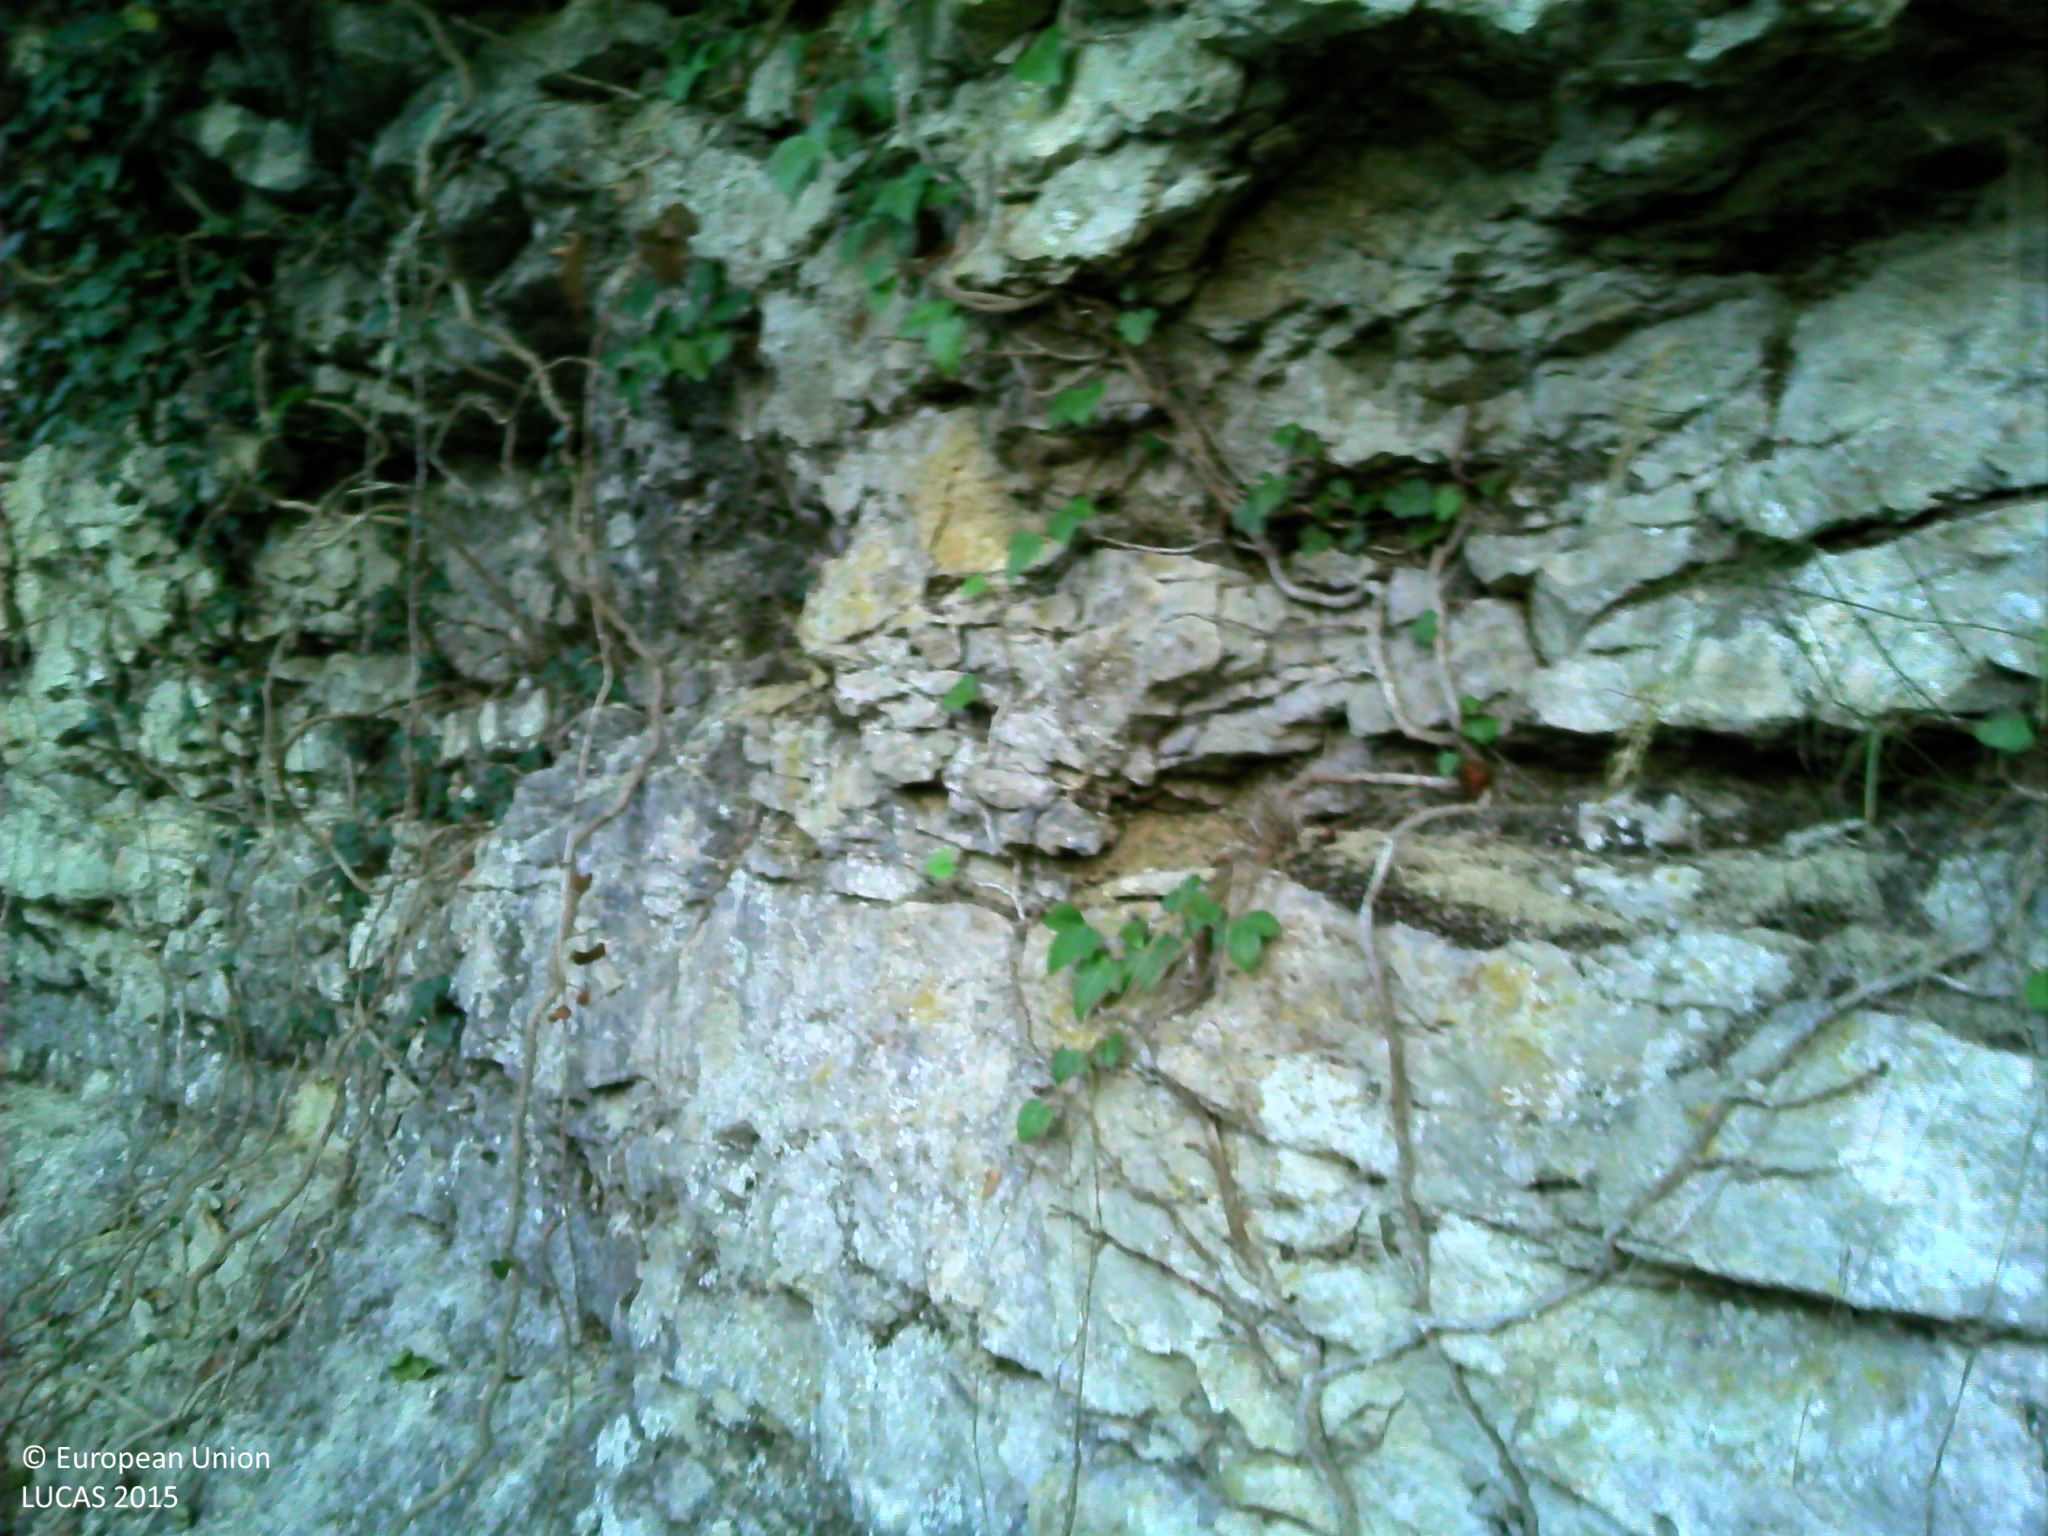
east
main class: Woodland
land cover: Broadleaved woodland
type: mesophytic deciduous forest
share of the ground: > 75 %
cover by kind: broadleaved forest trees 90 %, shrubs 5 %, herbaceous plants 5 %
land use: Forestry
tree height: > 5 m
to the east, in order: Broadleaved woodland; Rock outcrops; Broadleaved woodland
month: September
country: FR
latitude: 47.3145
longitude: 6.8667
